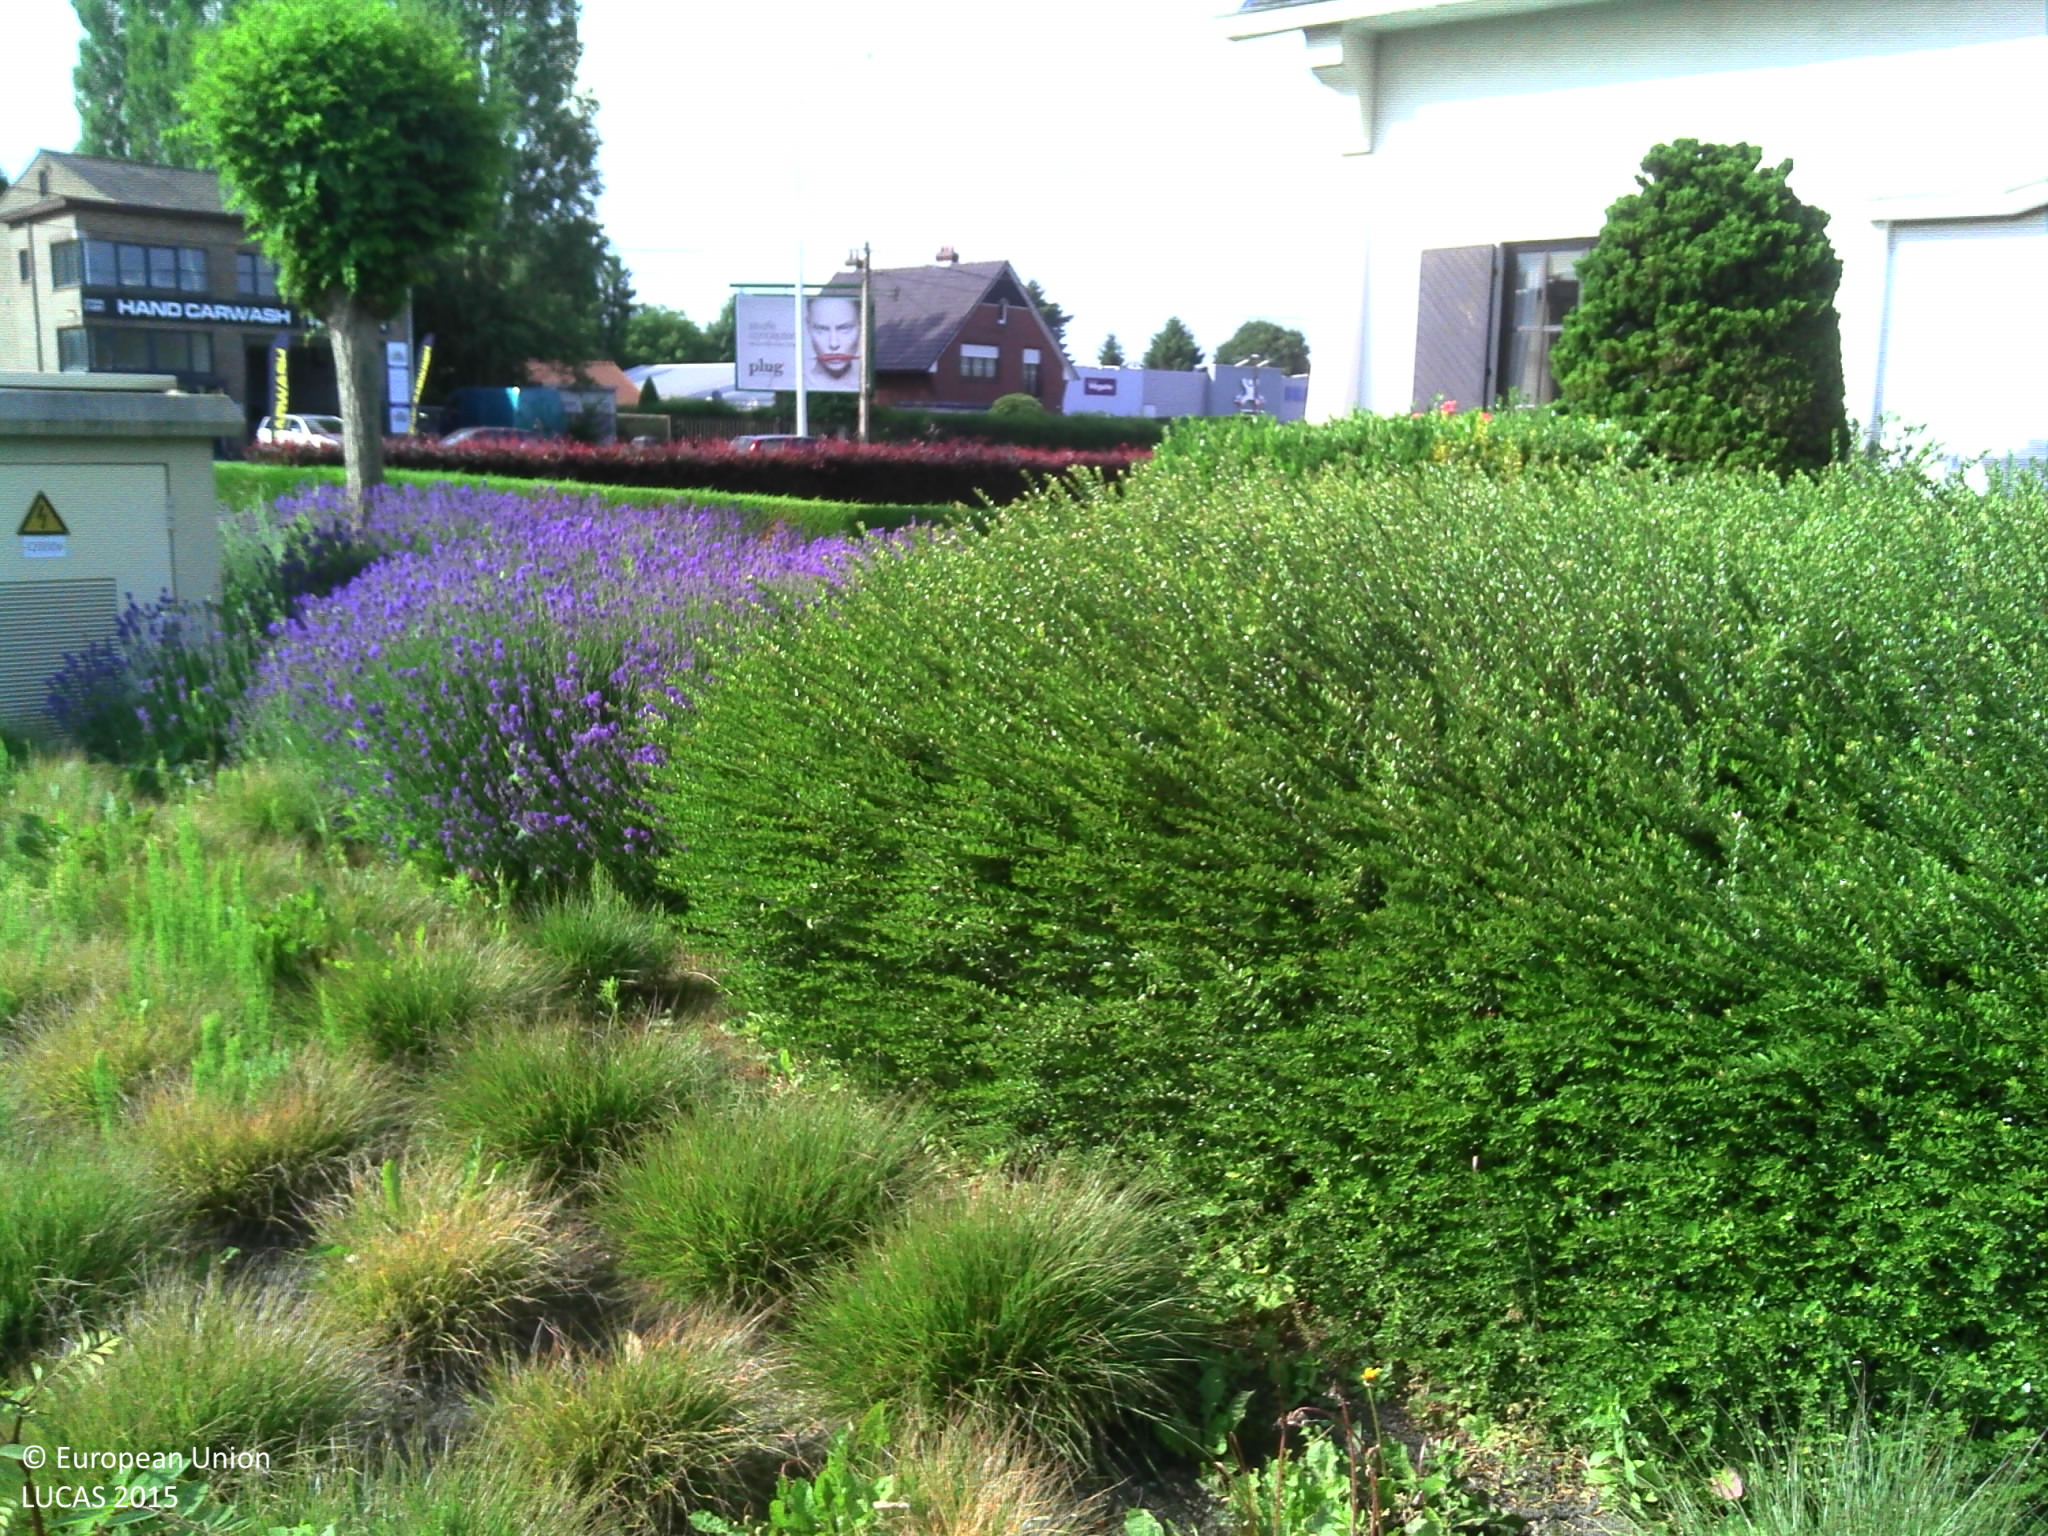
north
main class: Cropland
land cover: Floriculture and ornamental plants
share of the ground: > 75 %
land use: Community services
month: June
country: BE
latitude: 51.0787
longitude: 3.7842
